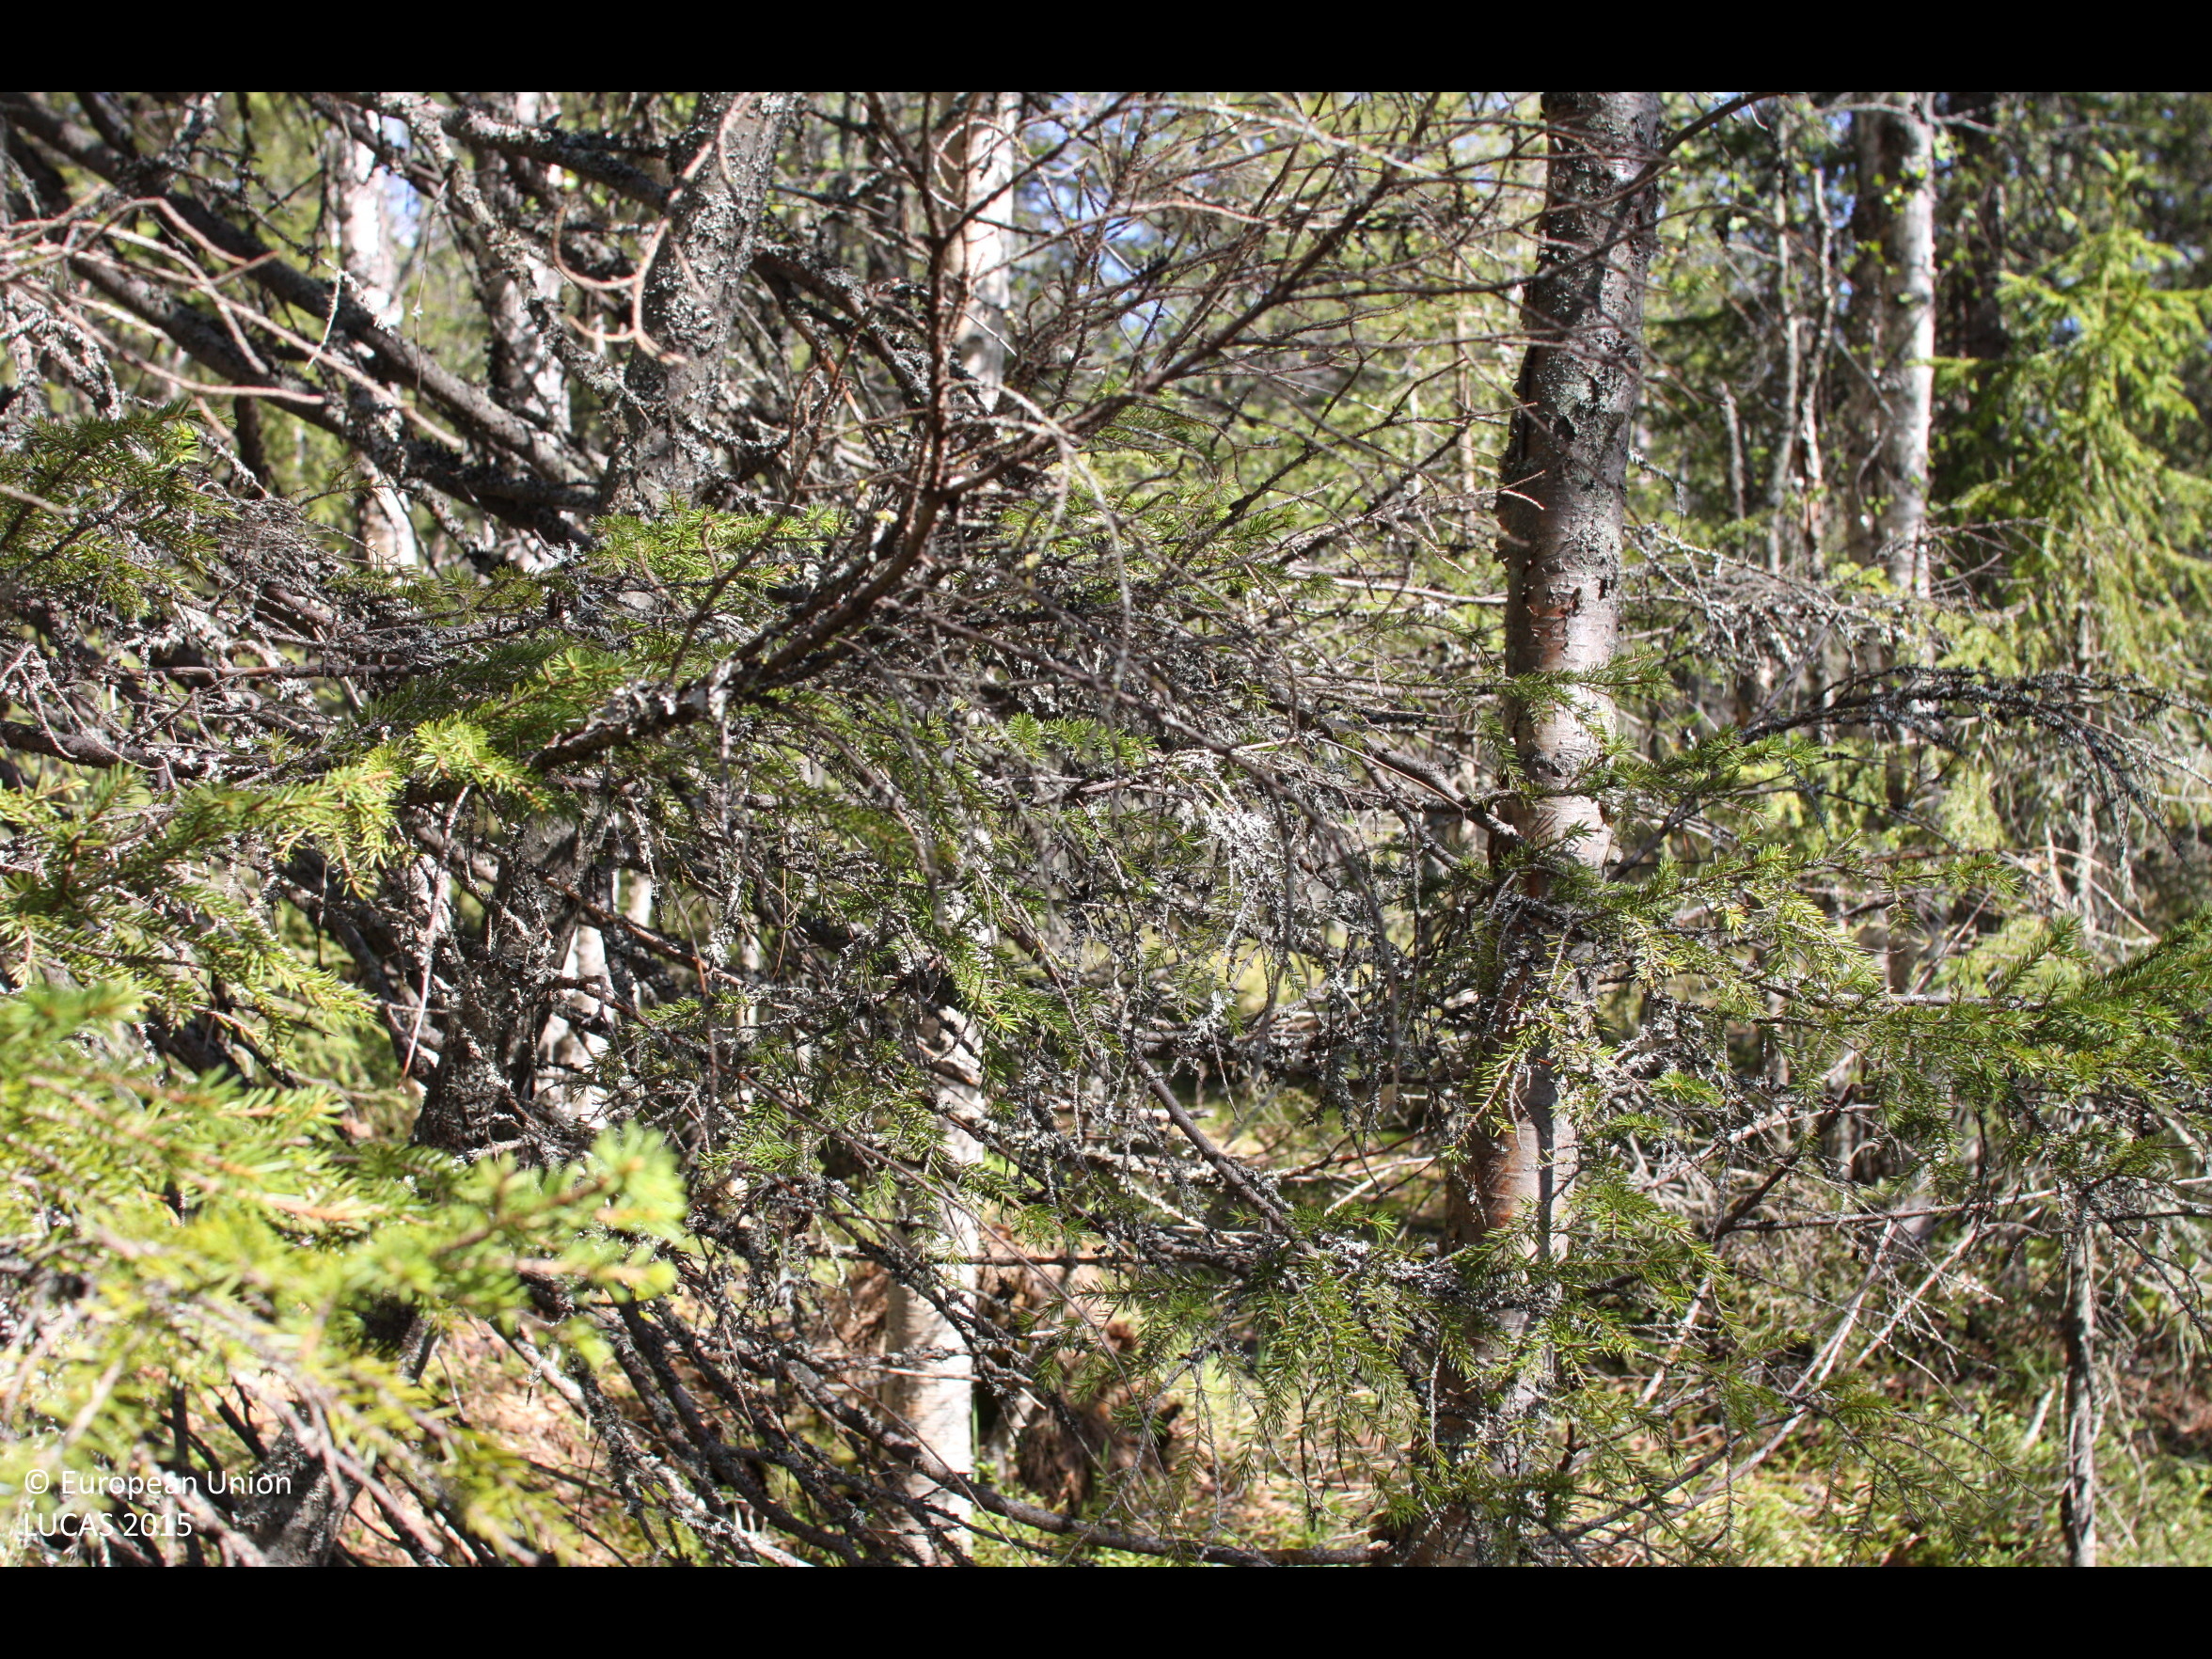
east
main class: Woodland
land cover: Spruce dominated mixed woodland
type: boreal forest
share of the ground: > 75 %
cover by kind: coniferous forest trees 40 %, broadleaved forest trees 40 %, shrubs 20 %
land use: Forestry
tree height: > 5 m
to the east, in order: Spruce dominated mixed woodland; Other coniferous woodland; Spruce dominated coniferous woodland; Other mixed woodland; Ditches and canals; Pine dominated mixed woodland; Ditches and canals; Pine dominated coniferous woodland
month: June
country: FI
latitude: 66.2062
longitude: 27.6949
